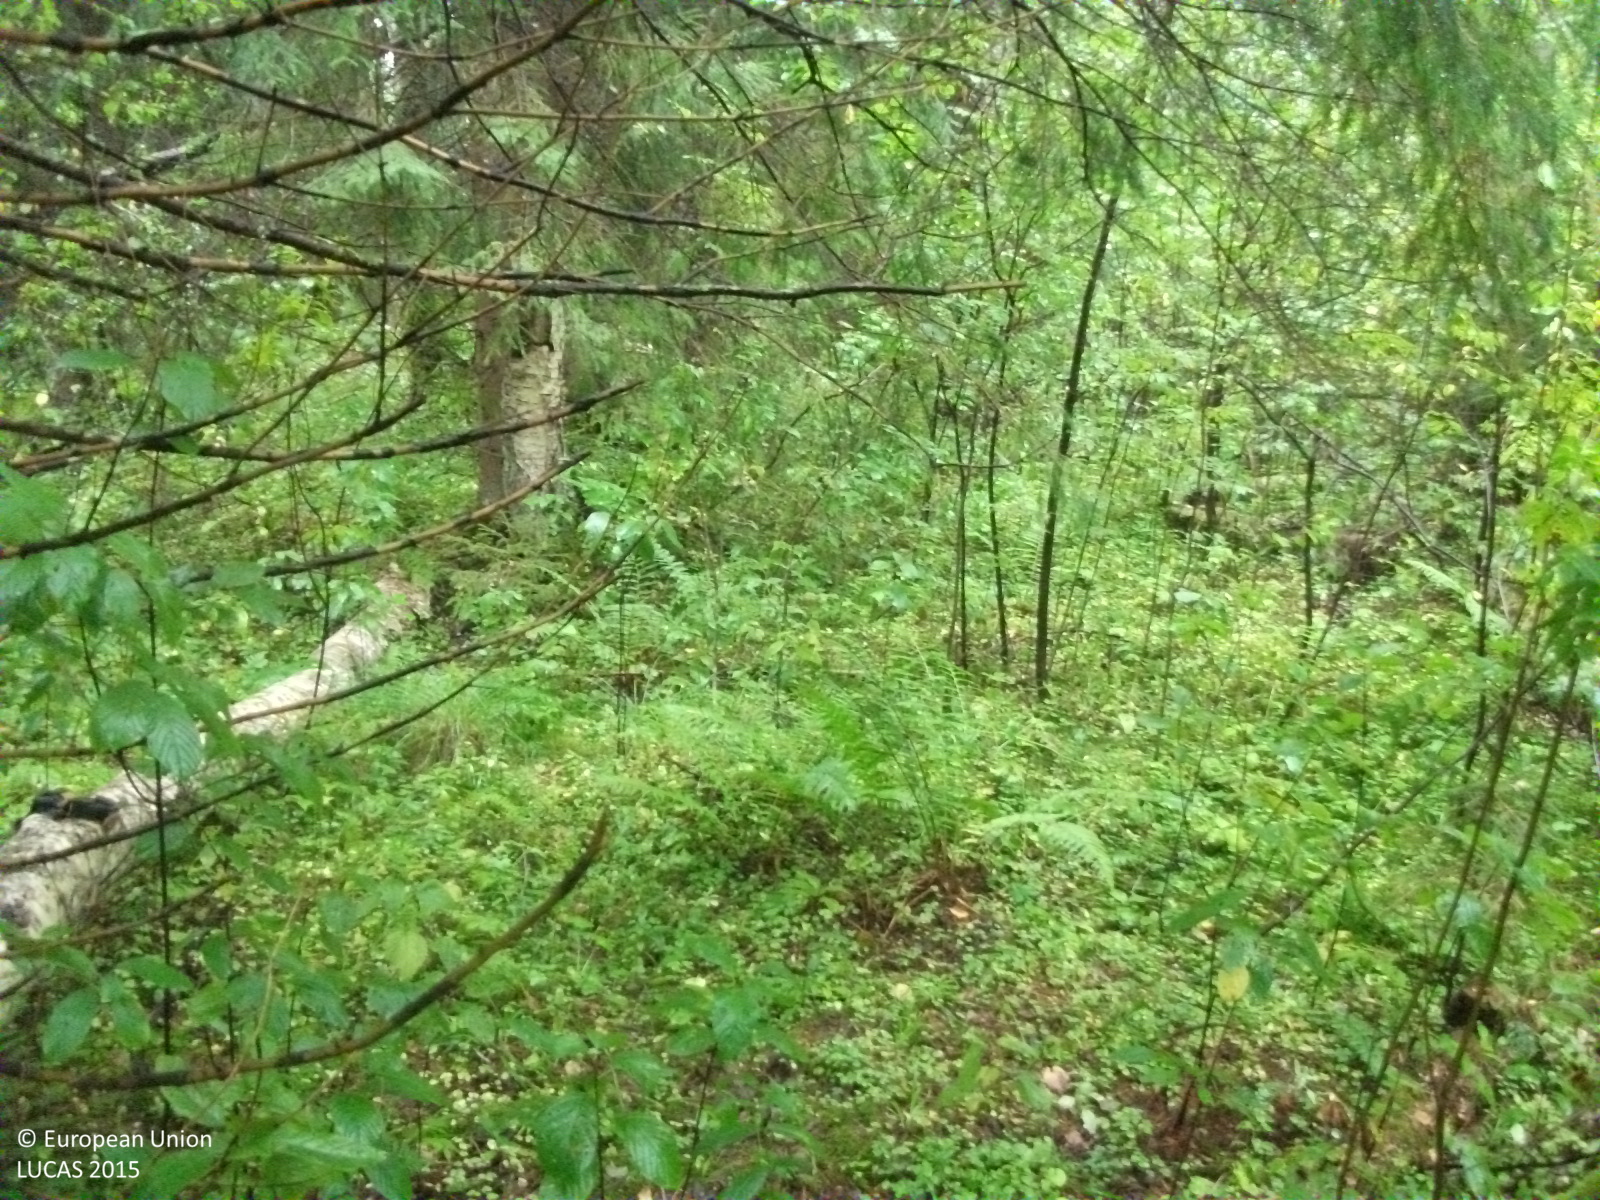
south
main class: Woodland
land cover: Spruce dominated mixed woodland
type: hemiboreal forest and nemoral coniferous forest and mixed broadleaved-coniferous forest
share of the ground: > 75 %
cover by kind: coniferous forest trees 55 %, broadleaved forest trees 30 %, herbaceous plants 10 %, shrubs 5 %
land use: Forestry
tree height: > 5 m
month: September
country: LV
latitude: 56.5975
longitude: 26.0804
